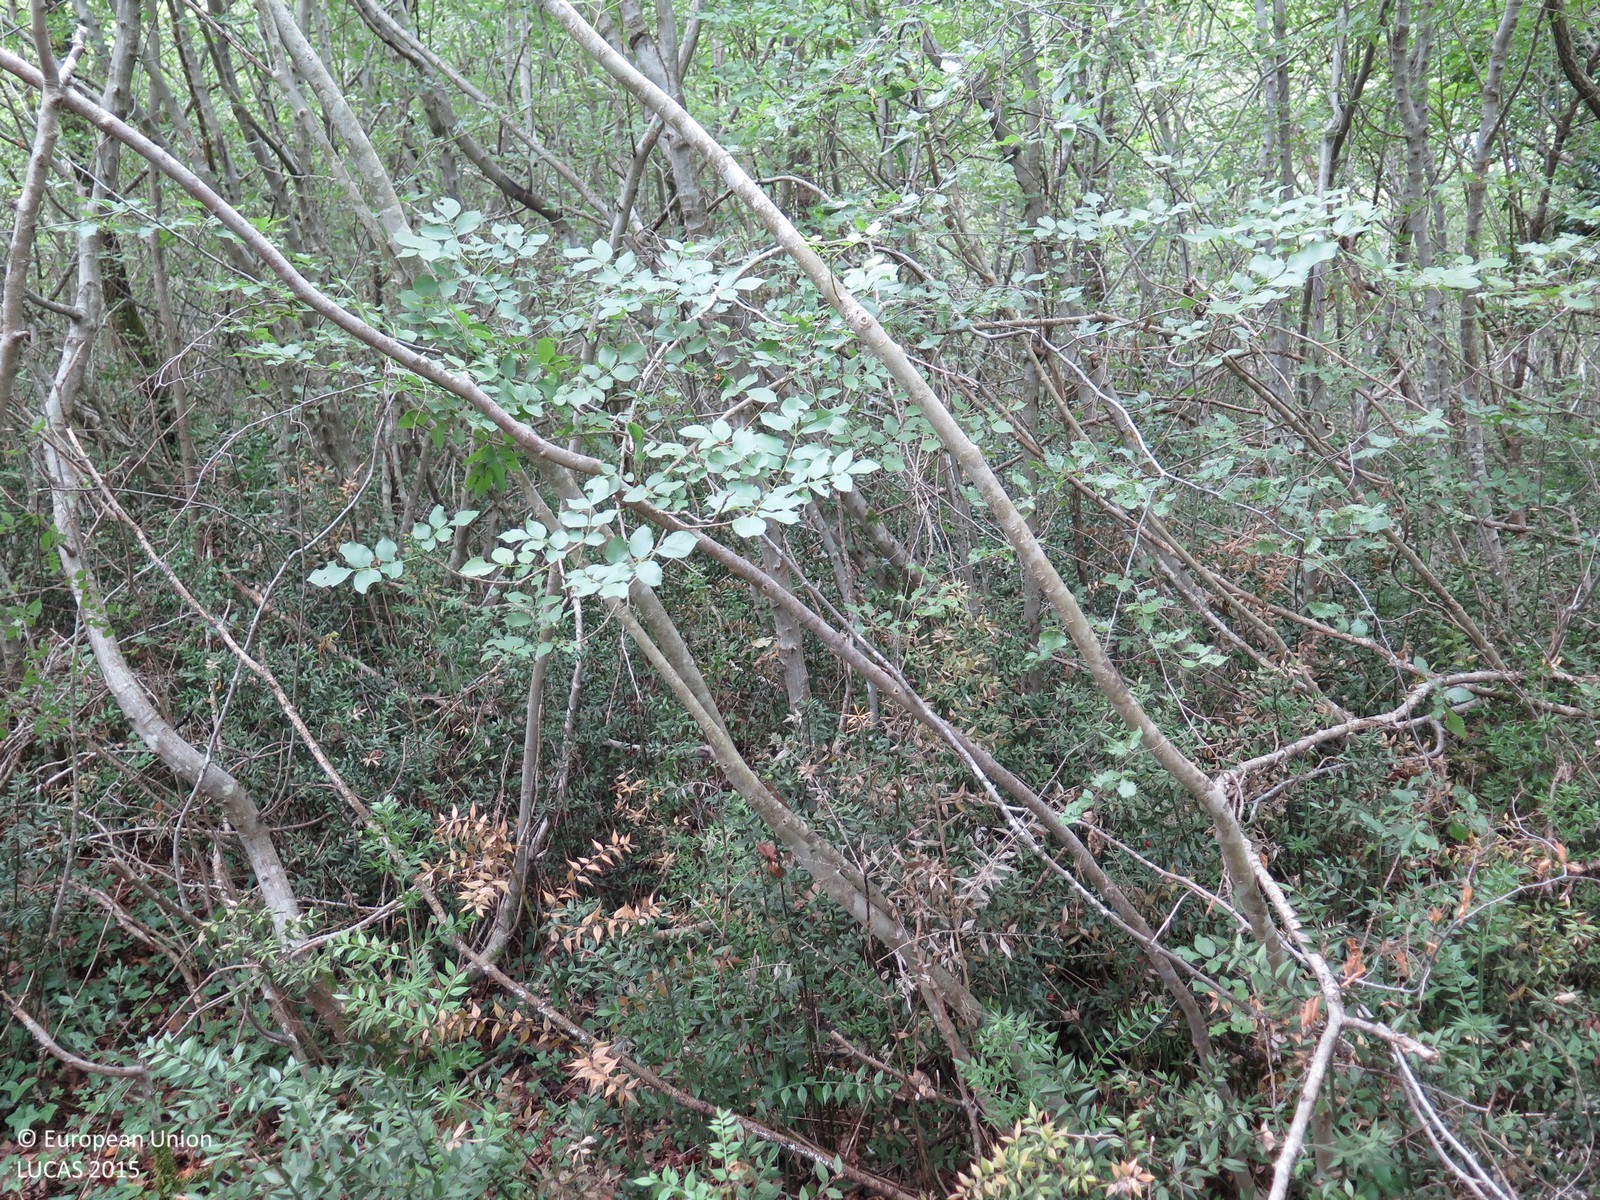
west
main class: Woodland
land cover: Broadleaved woodland
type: beech forest
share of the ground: > 75 %
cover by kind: broadleaved forest trees 95 %, shrubs 5 %
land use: Semi-natural and natural areas not in use
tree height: > 5 m
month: June
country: HR
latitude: 45.2428
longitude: 13.6512
